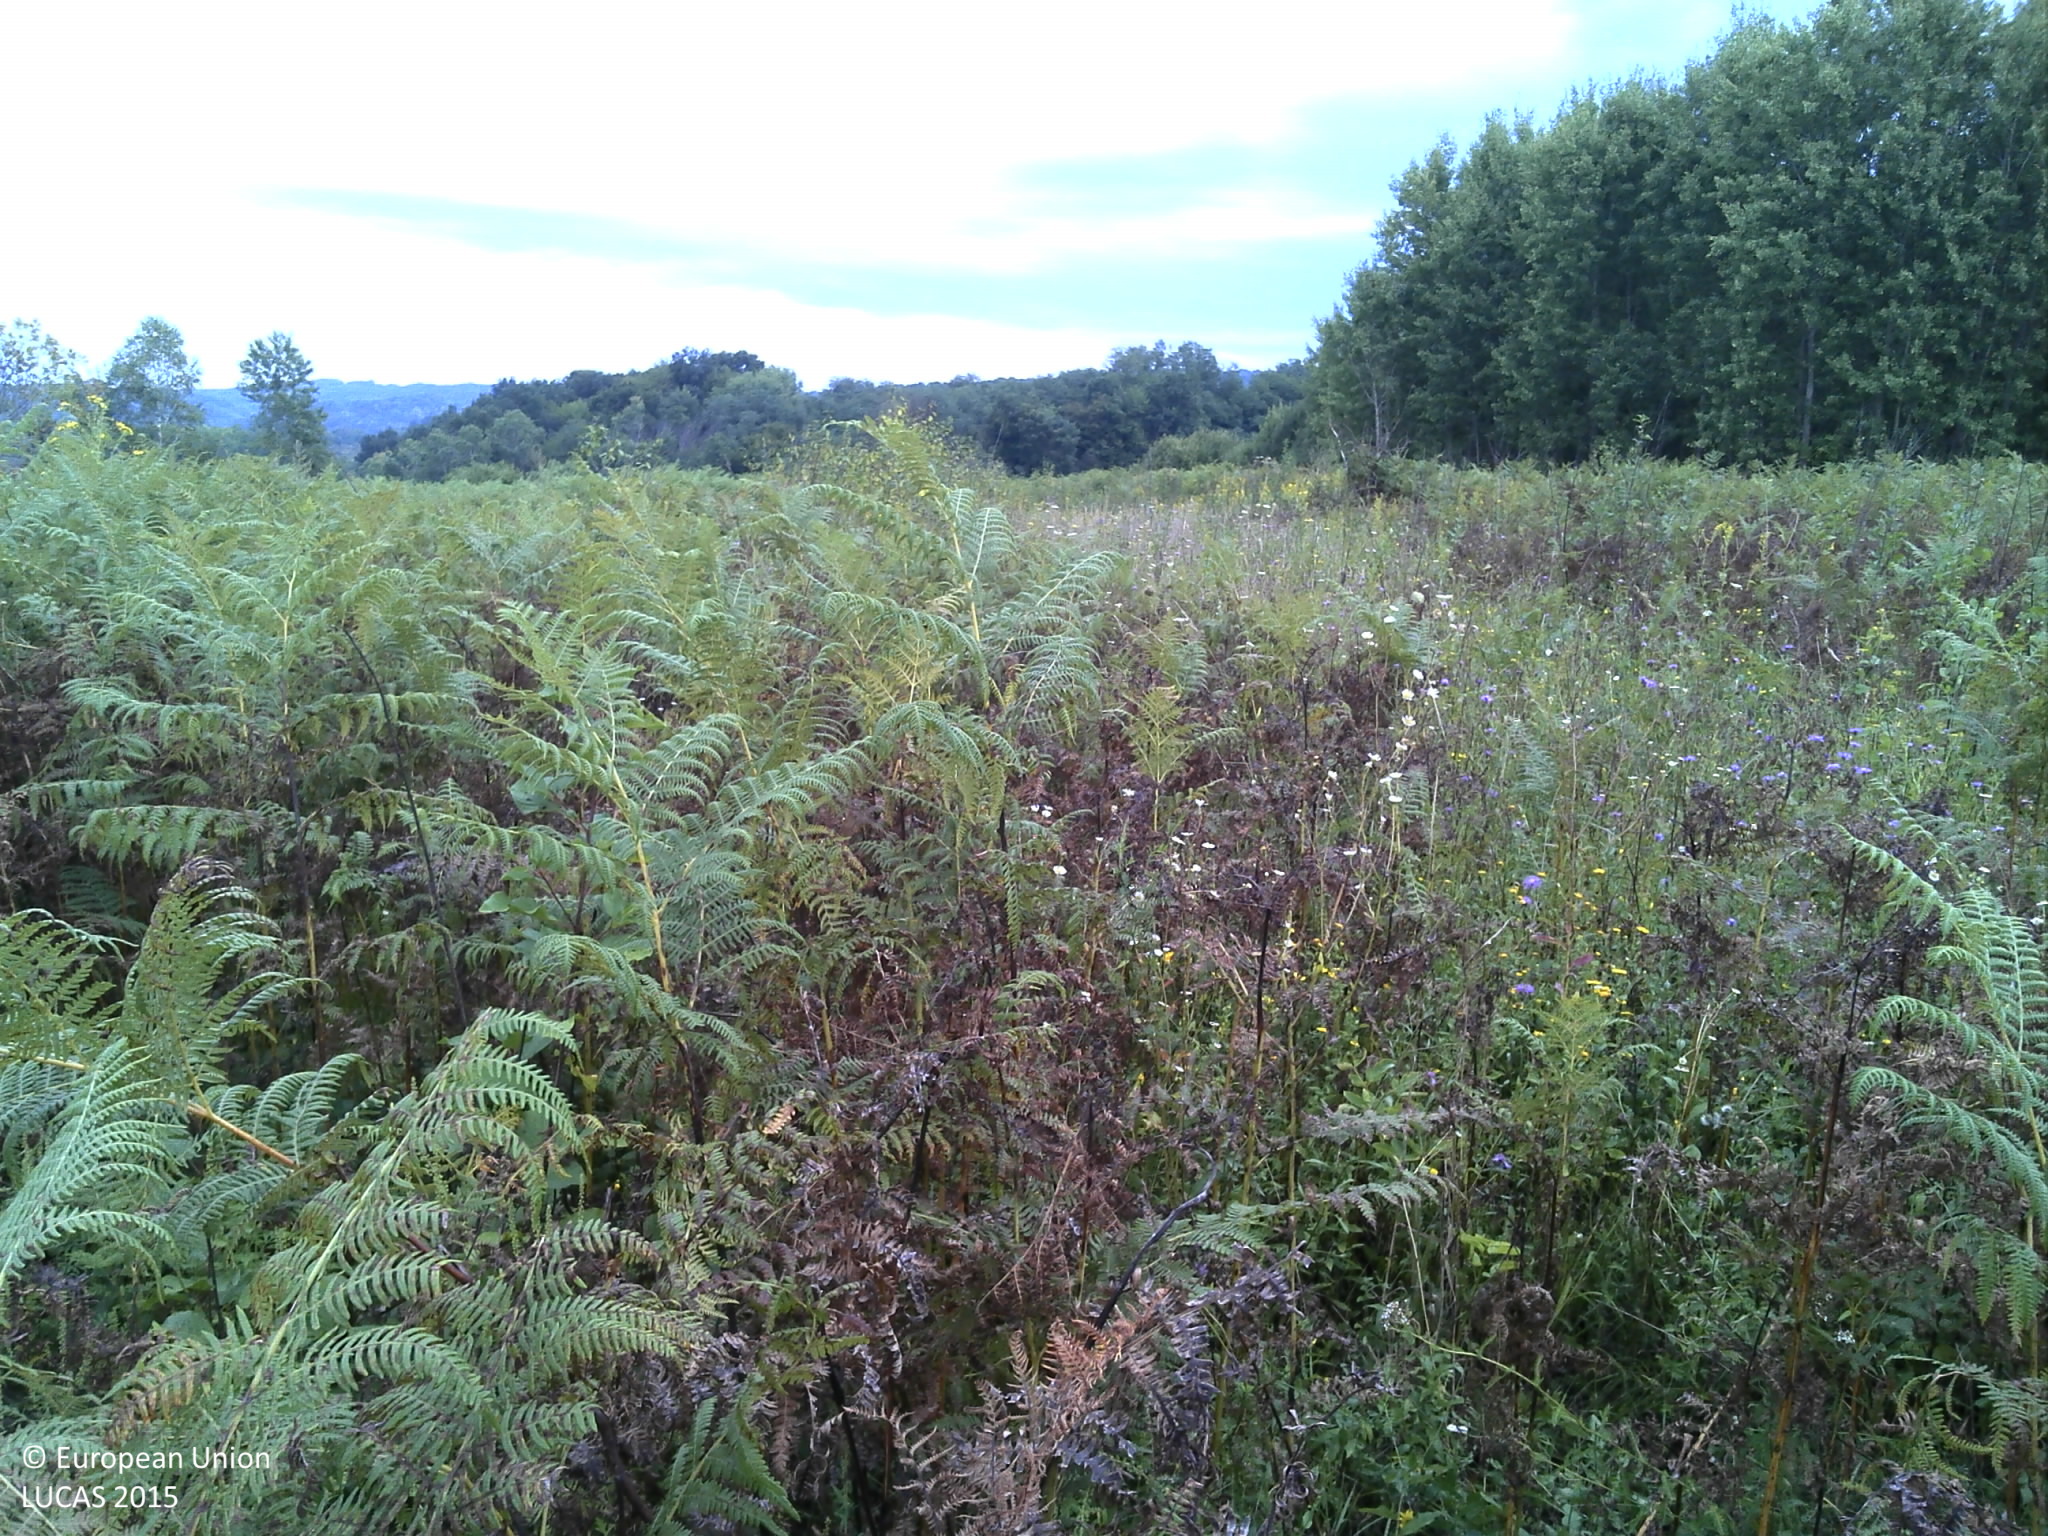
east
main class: Grassland
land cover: Spontaneously vegetated surfaces
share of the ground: > 75 %
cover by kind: herbaceous plants 100 %
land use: Semi-natural and natural areas not in use
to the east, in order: Spontaneously vegetated surfaces
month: August
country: HR
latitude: 45.2886
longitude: 16.1550
